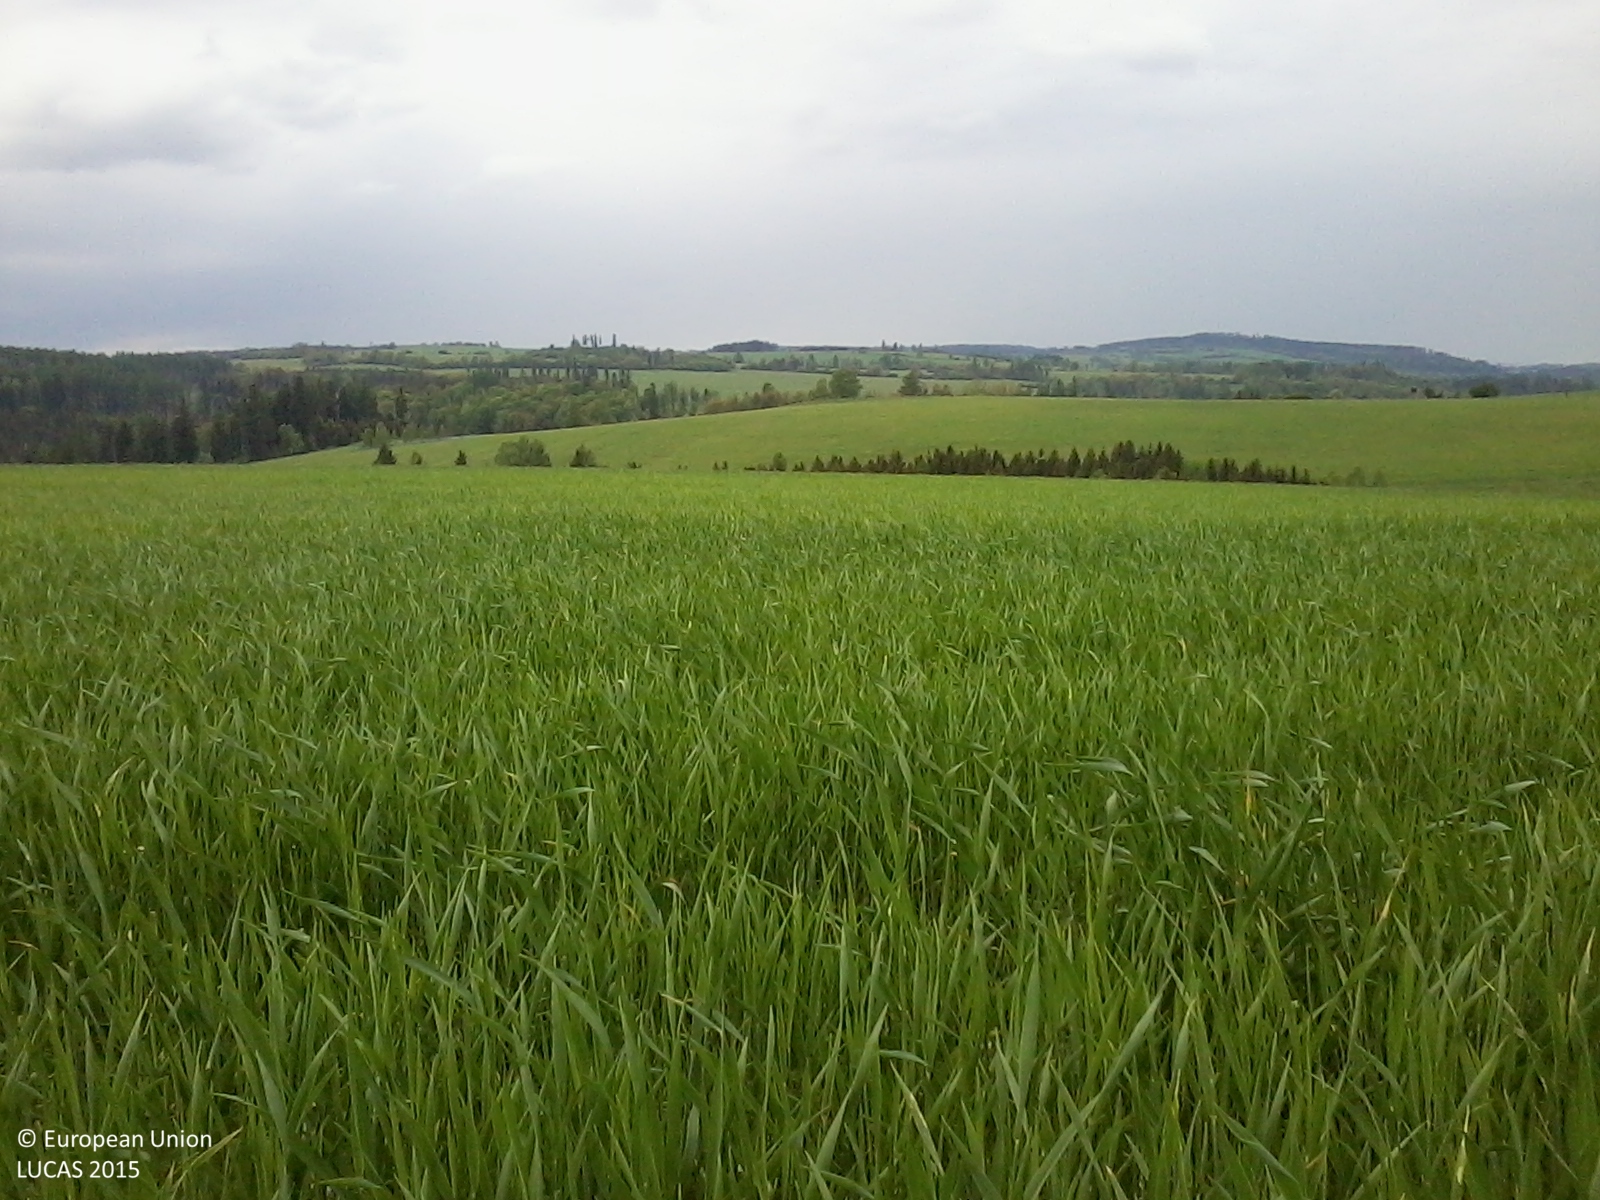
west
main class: Cropland
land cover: Common wheat
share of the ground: > 75 %
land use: Agriculture (excluding fallow land and kitchen gardens)
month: May
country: CZ
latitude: 49.7815
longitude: 17.6655
